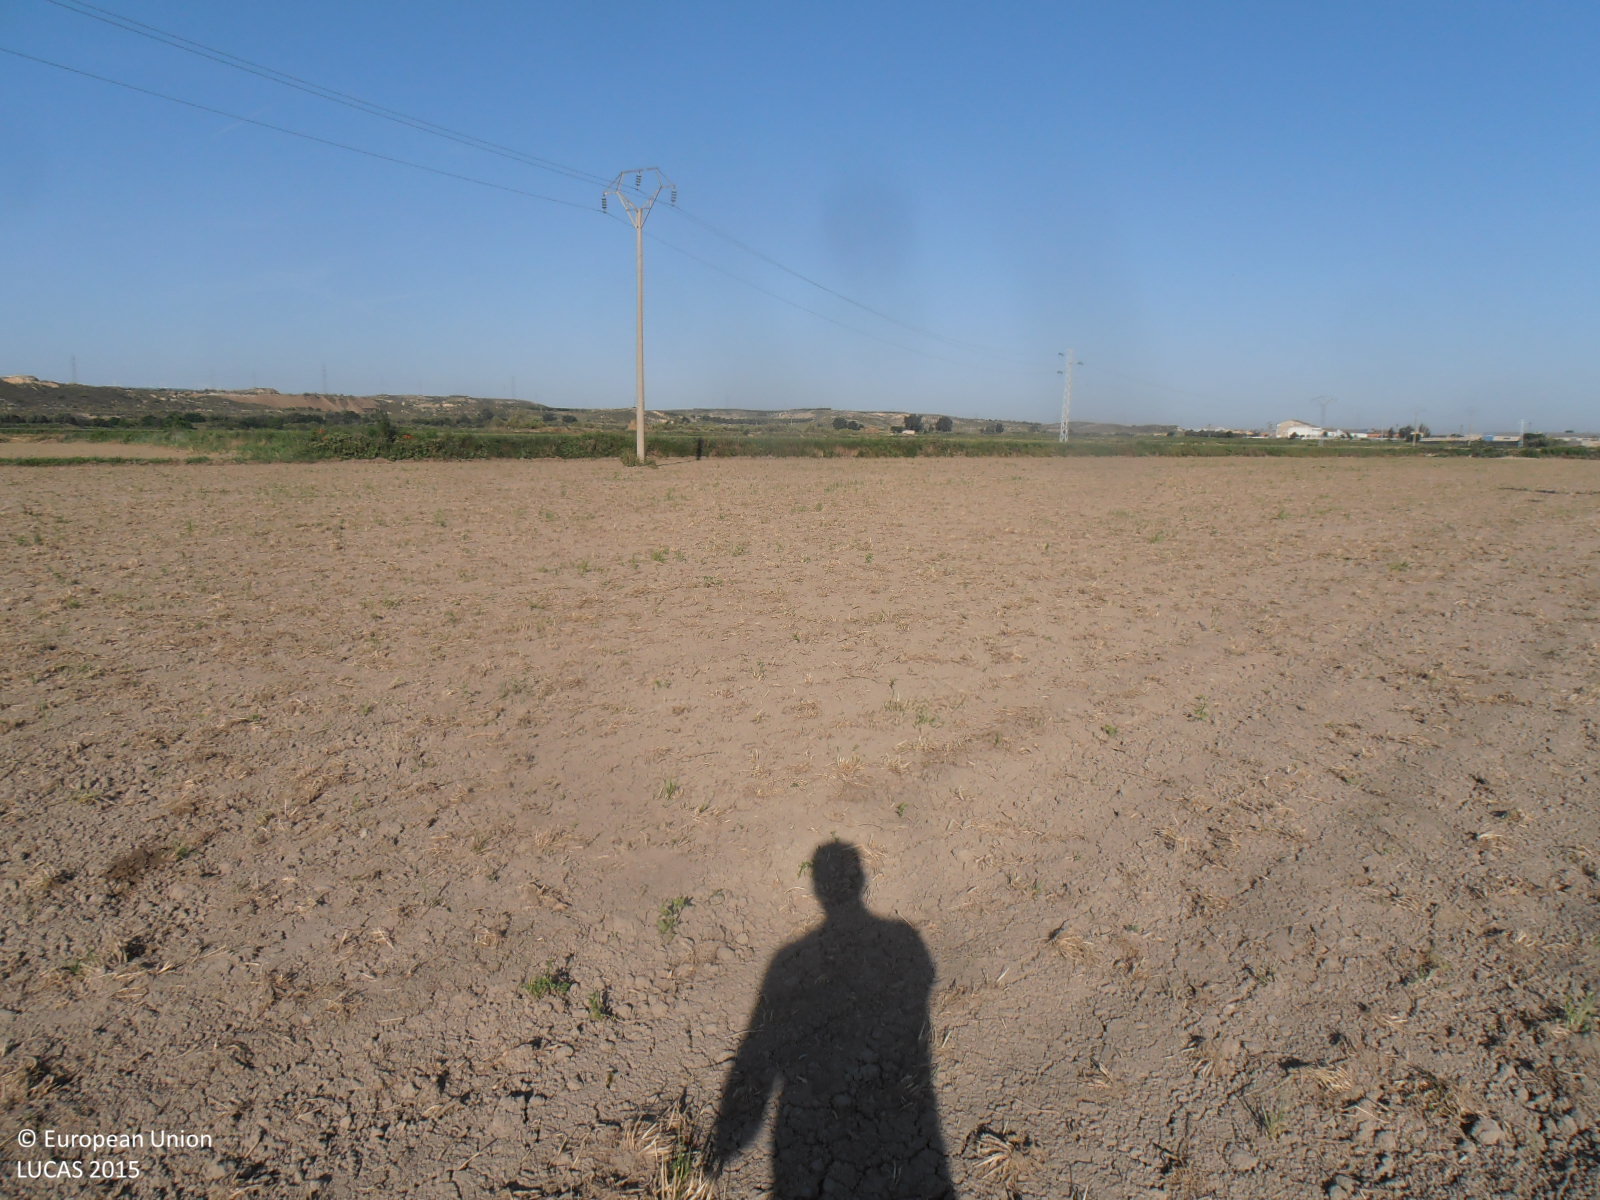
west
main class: Cropland
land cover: Maize
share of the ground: < 10 %
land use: Agriculture (excluding fallow land and kitchen gardens)
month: May
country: ES
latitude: 41.5853
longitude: -0.7801
